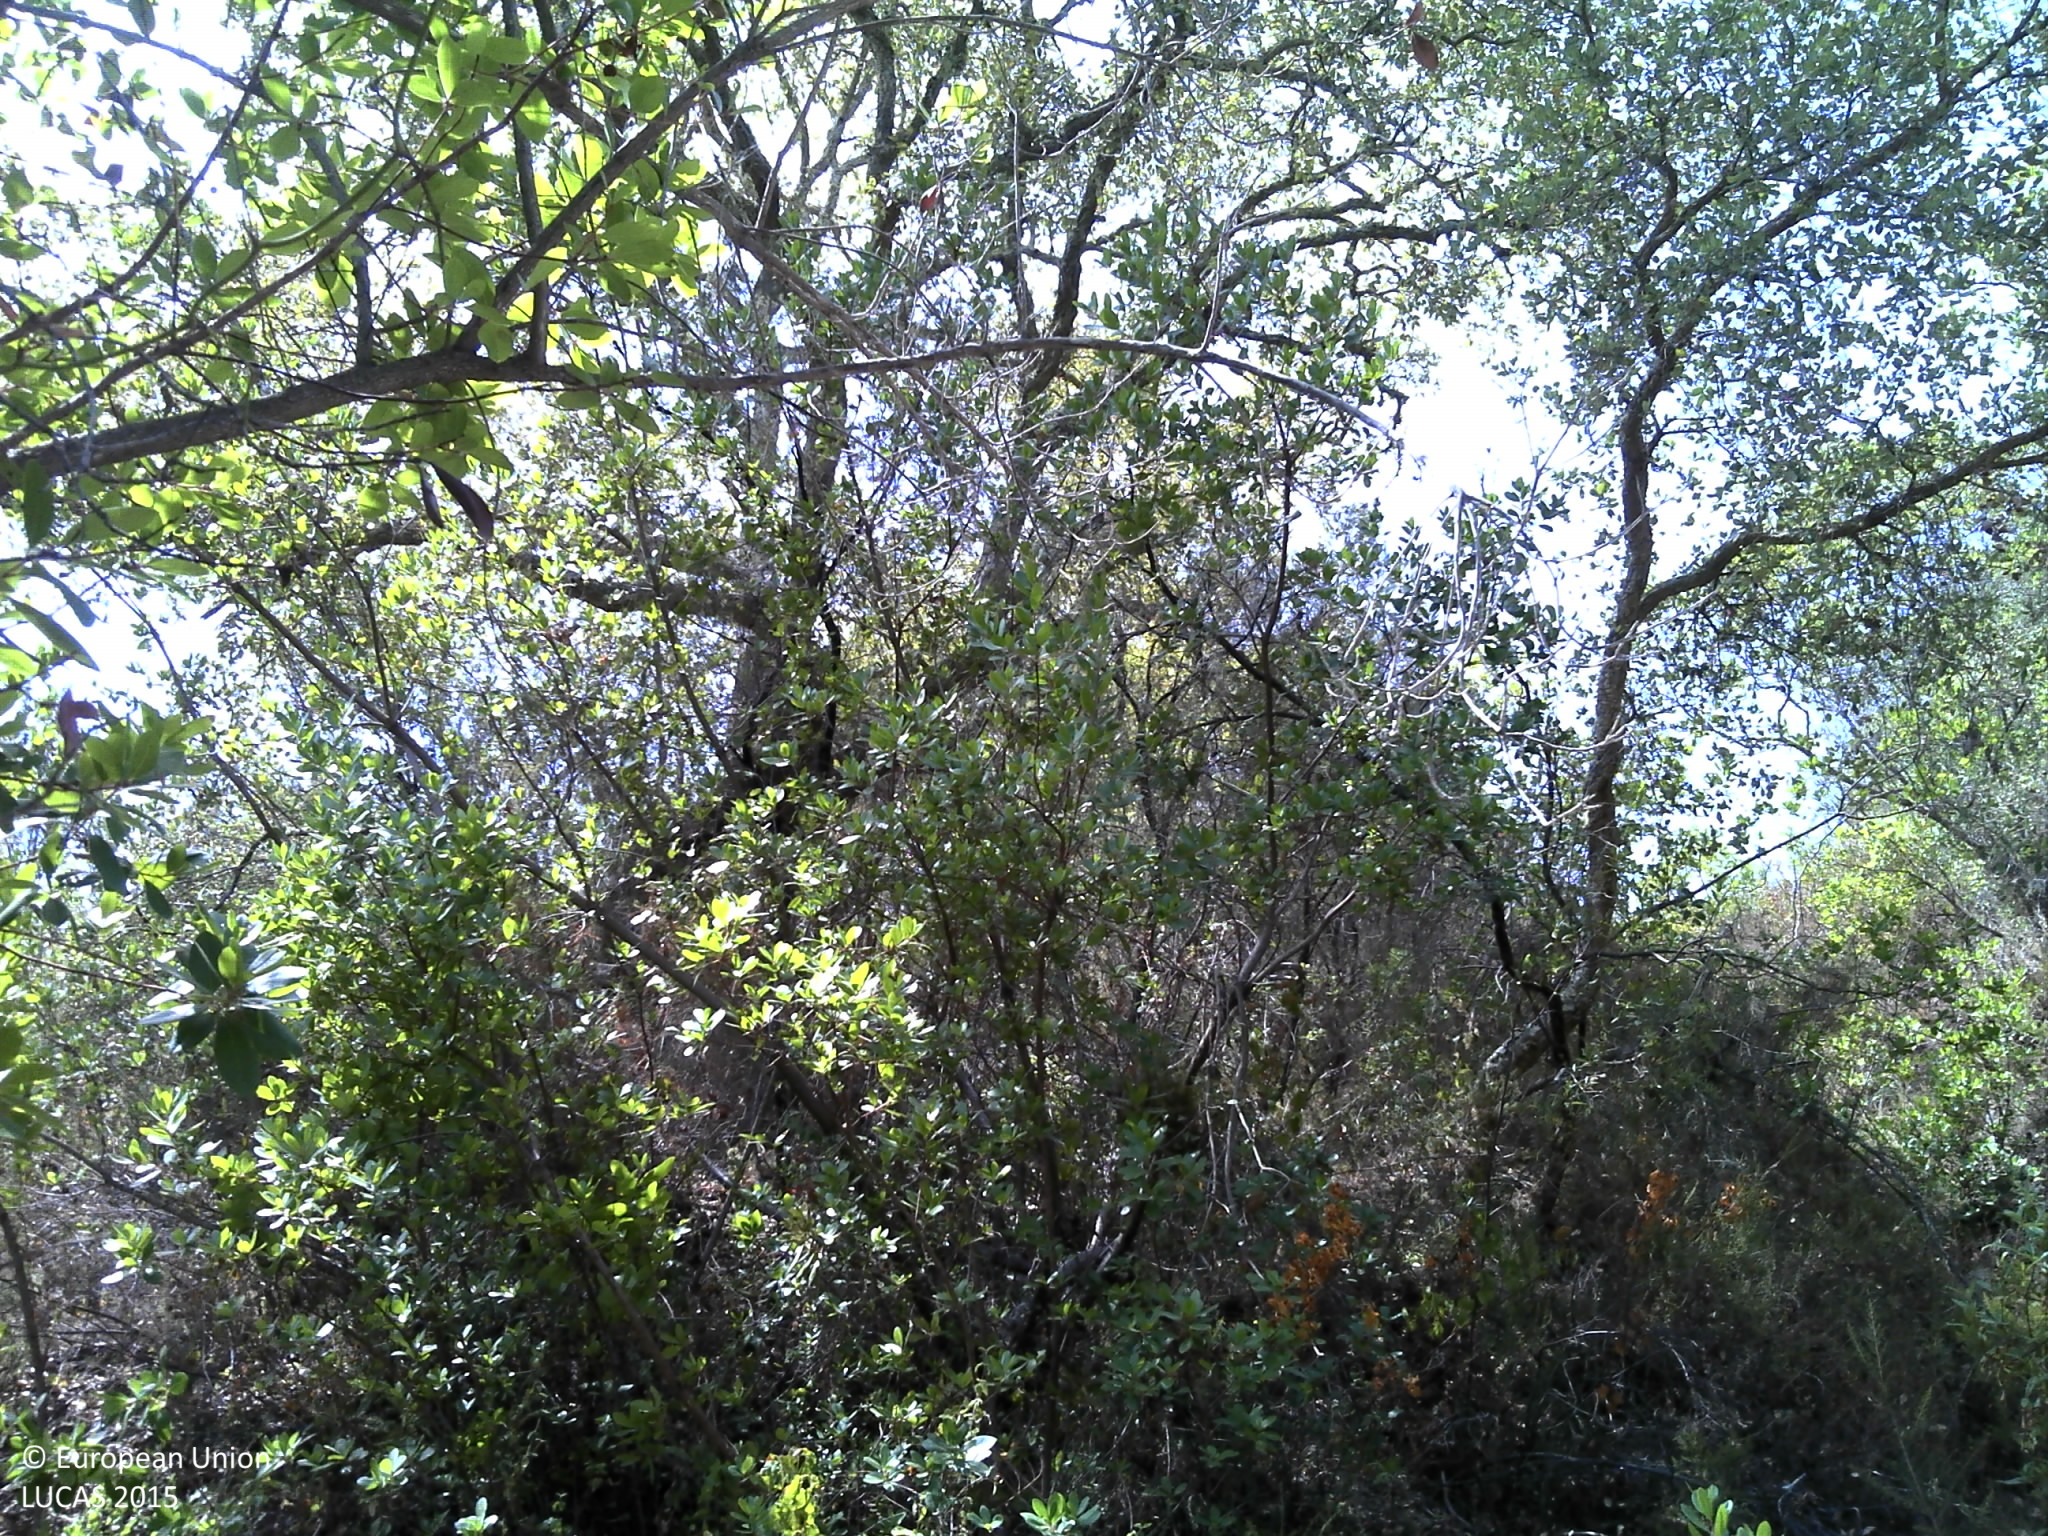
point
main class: Woodland
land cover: Broadleaved woodland
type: broadleaved evergreen forest
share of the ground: 25 - 50 %
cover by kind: shrubs 50 %, broadleaved forest trees 30 %, unconsolidated bare surface 20 %
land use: Forestry
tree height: > 5 m
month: September
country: PT
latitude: 37.3930
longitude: -8.2434
